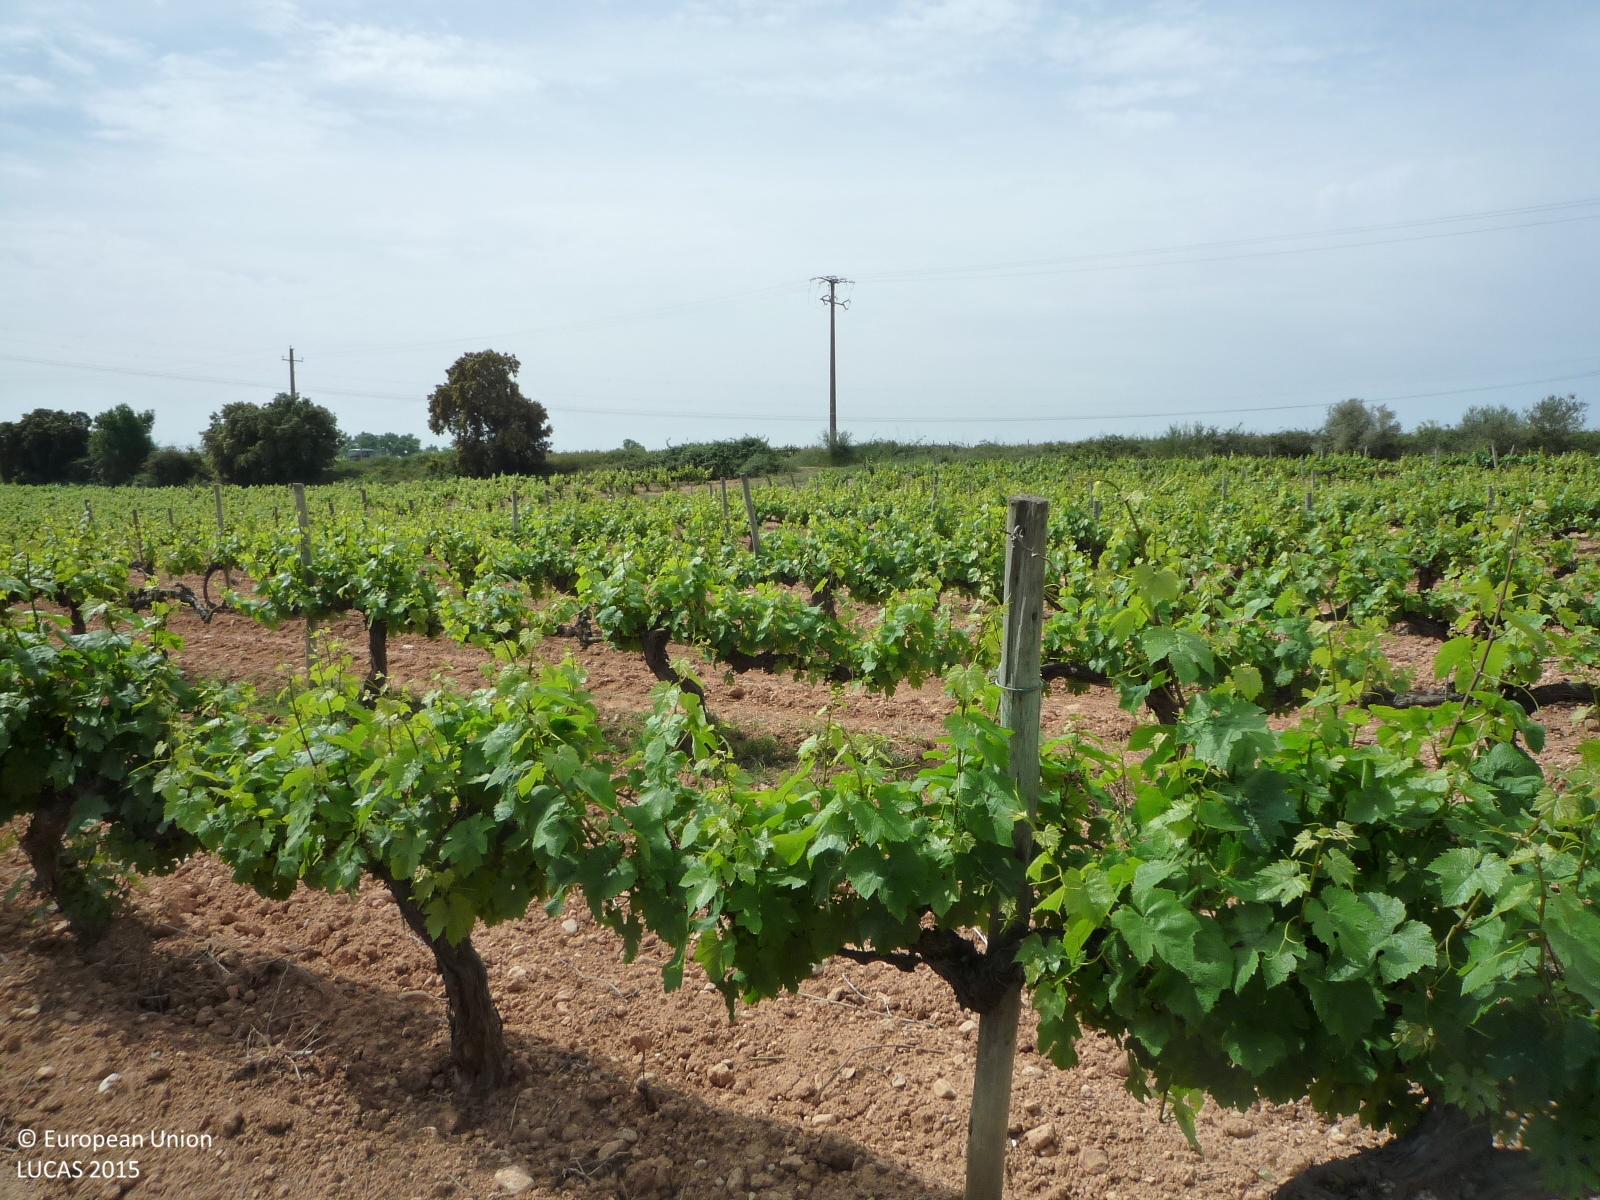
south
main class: Cropland
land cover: Vineyards
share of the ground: 10 - 25 %
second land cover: Other bare soil
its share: > 75 %
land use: Agriculture (excluding fallow land and kitchen gardens)
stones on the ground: 10 - 25 %
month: May
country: ES
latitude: 41.2878
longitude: 1.5994
